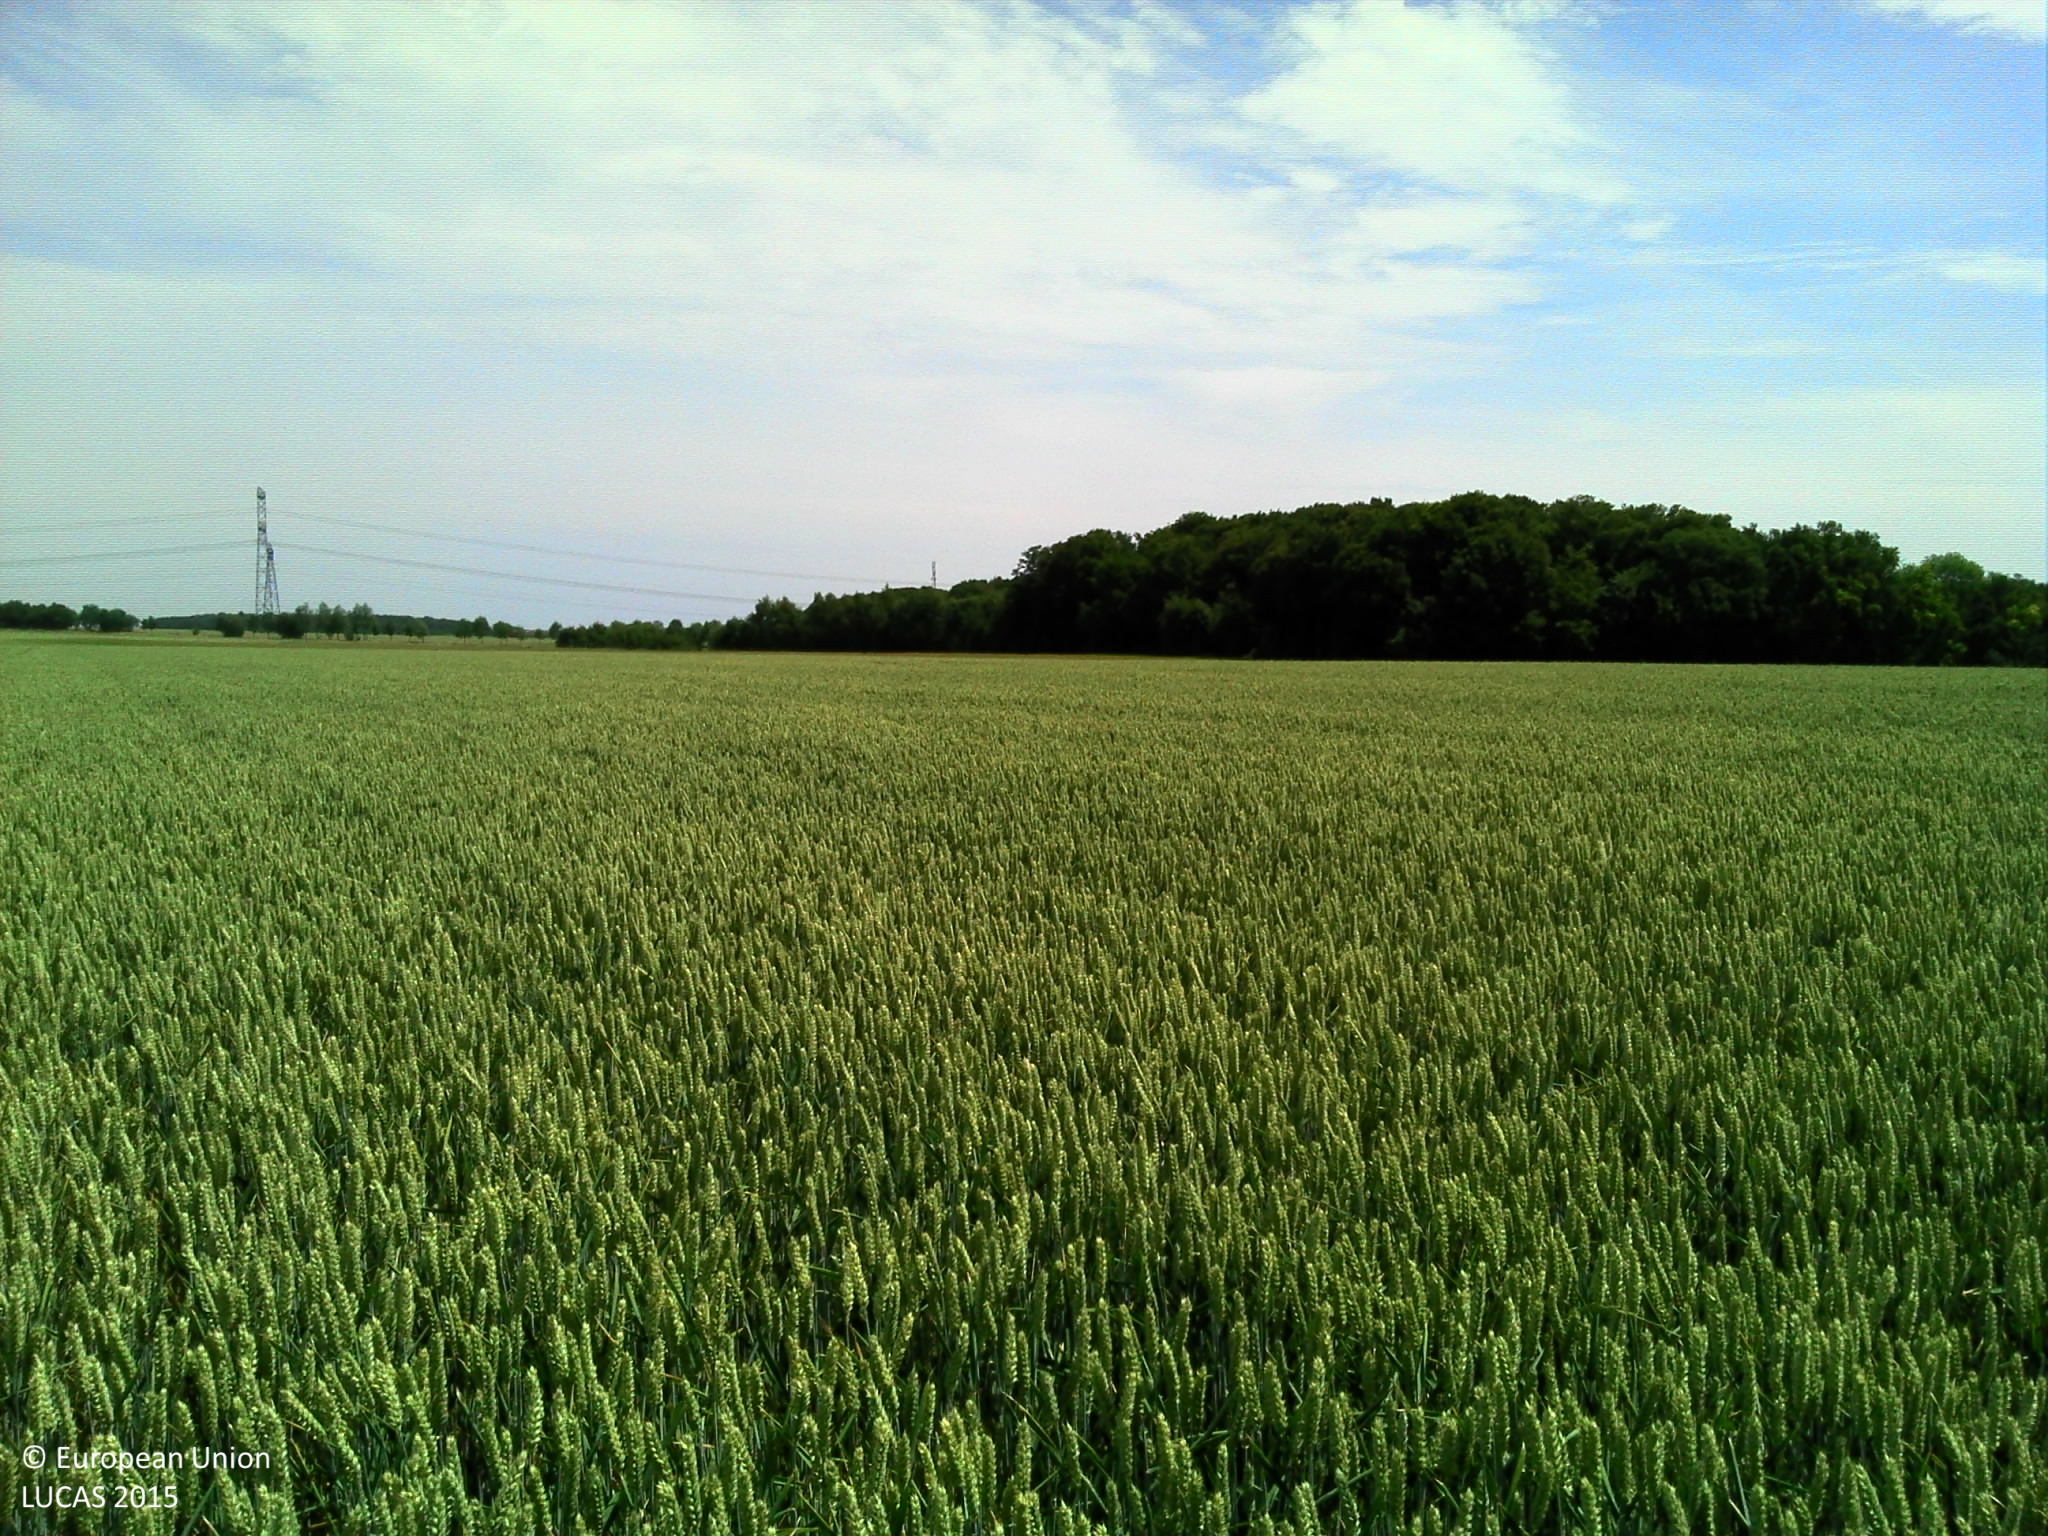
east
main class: Cropland
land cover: Common wheat
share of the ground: > 75 %
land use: Agriculture (excluding fallow land and kitchen gardens)
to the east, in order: Common wheat; Barley
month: June
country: FR
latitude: 49.6827
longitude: 2.2108
